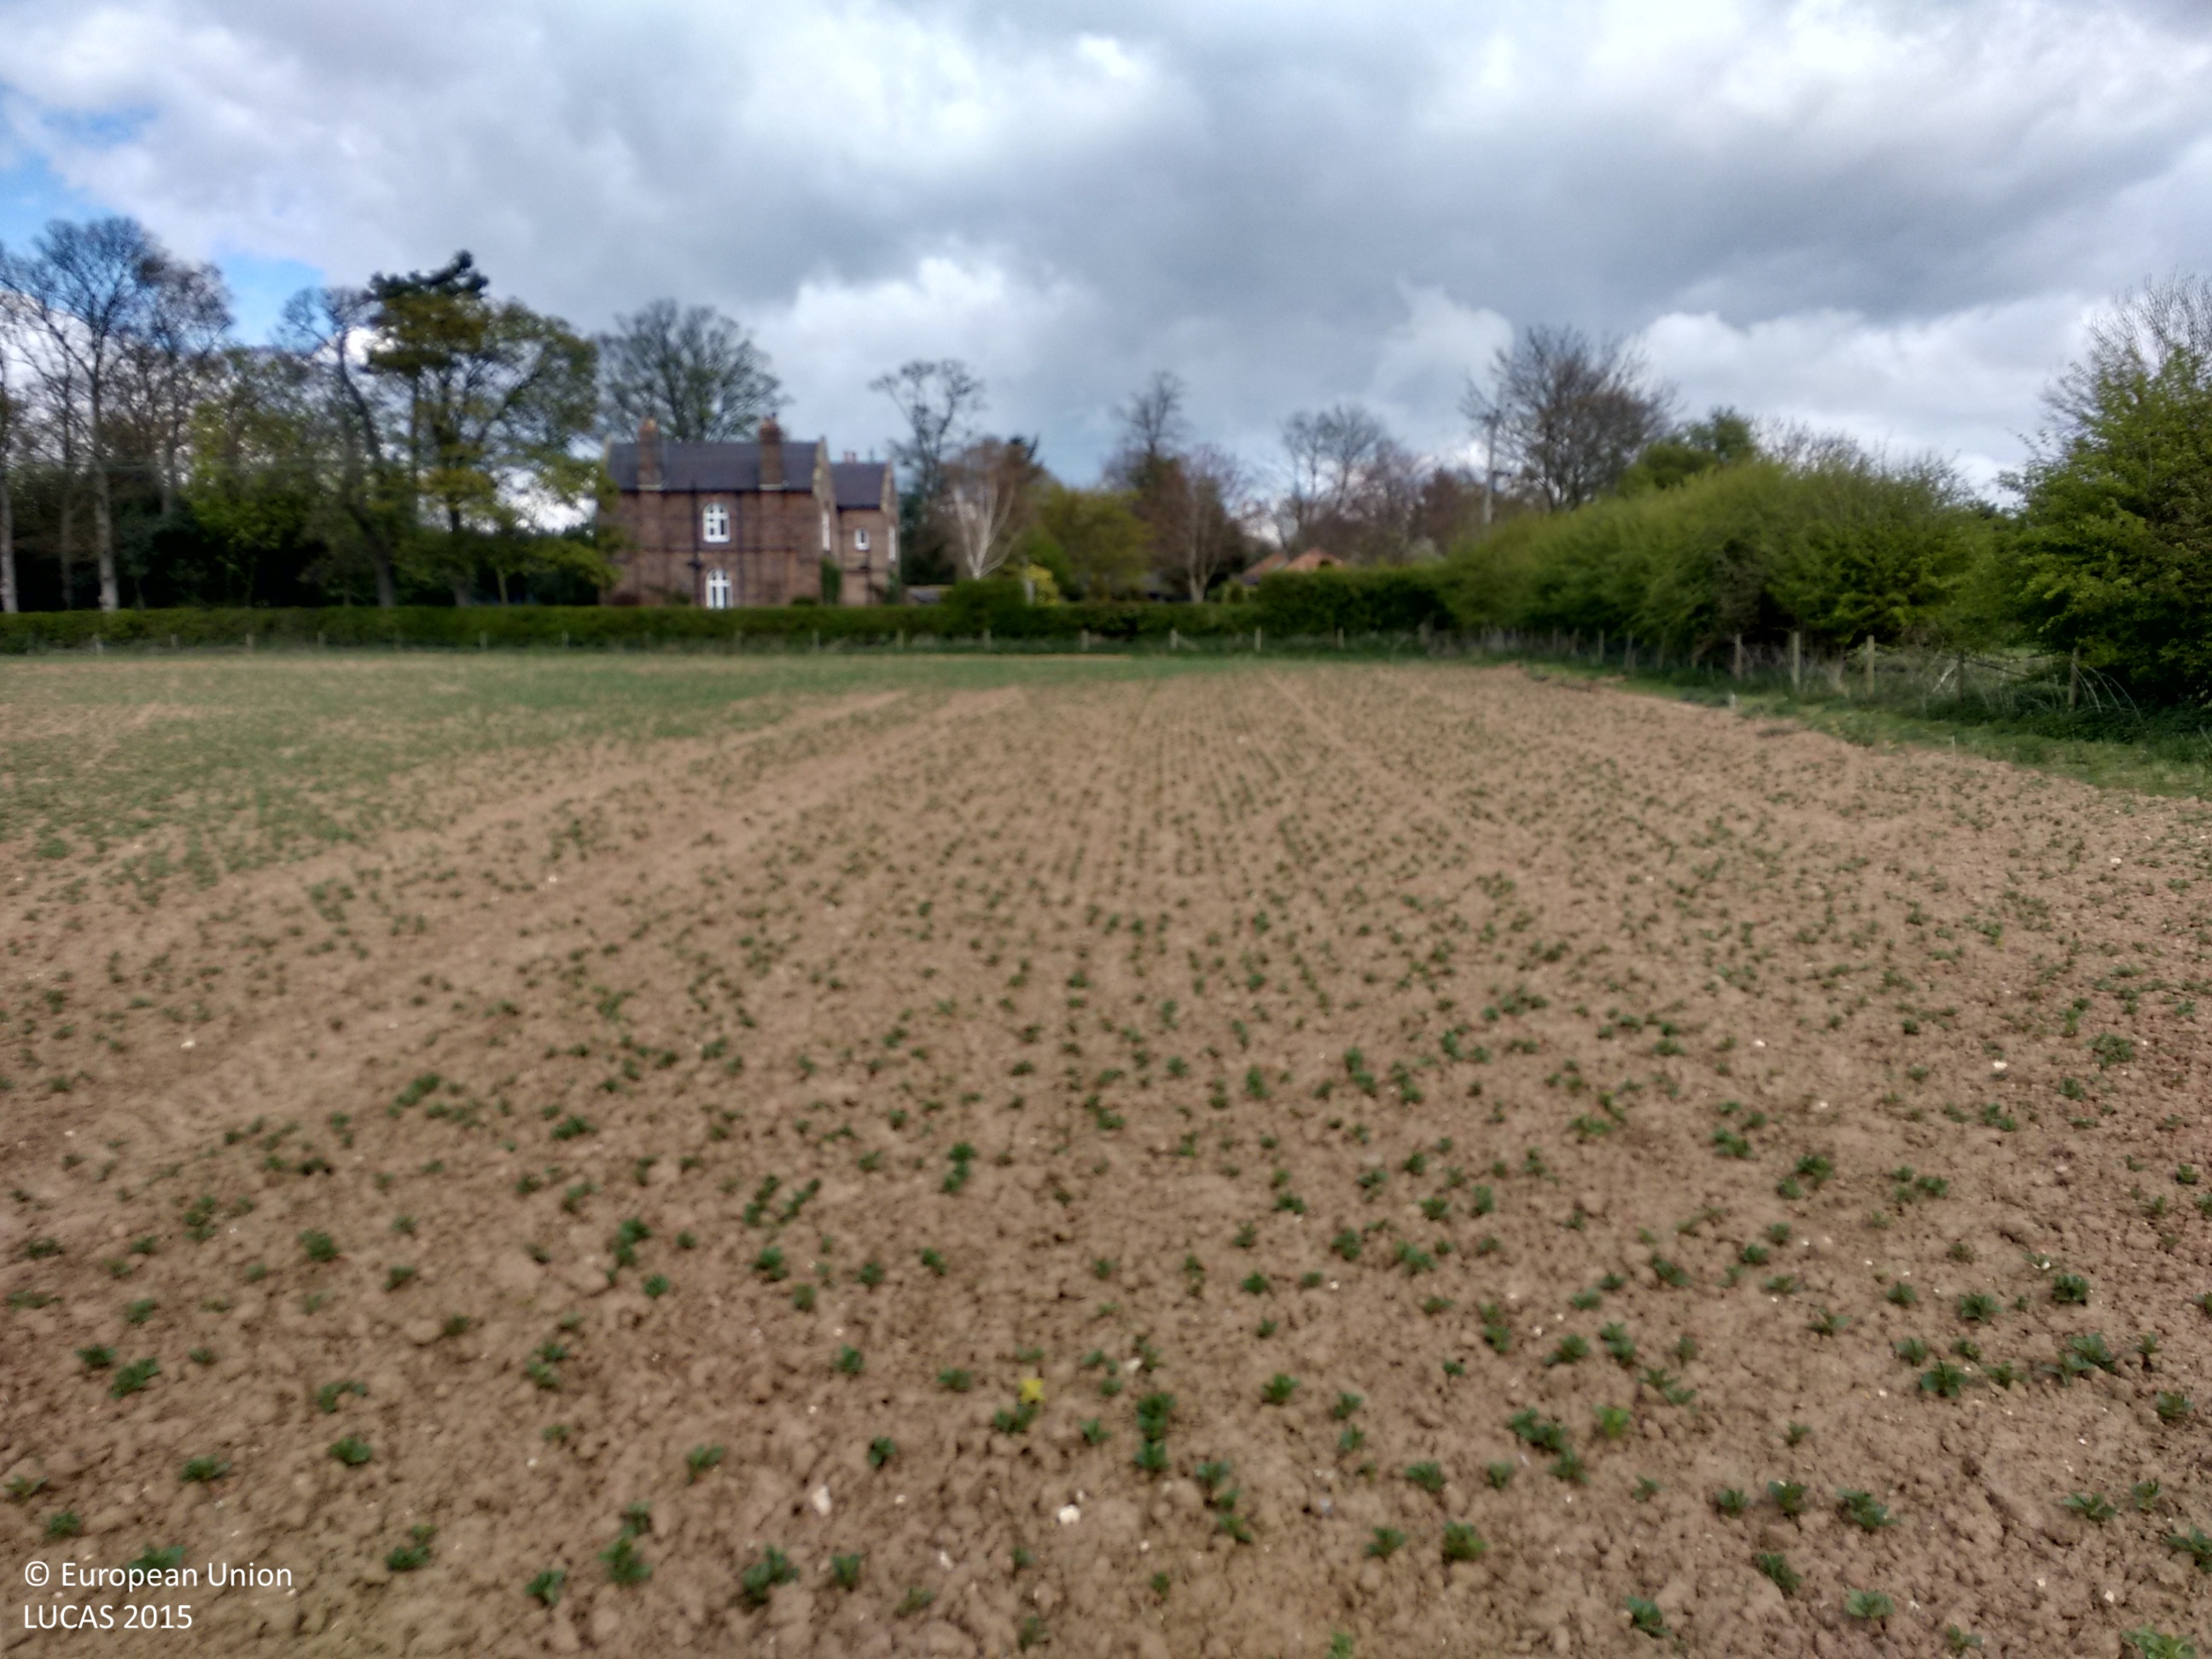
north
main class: Cropland
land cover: Dry pulses
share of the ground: 10 - 25 %
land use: Agriculture (excluding fallow land and kitchen gardens)
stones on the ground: < 10 %
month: April
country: GB
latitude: 54.0150
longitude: -0.4903
